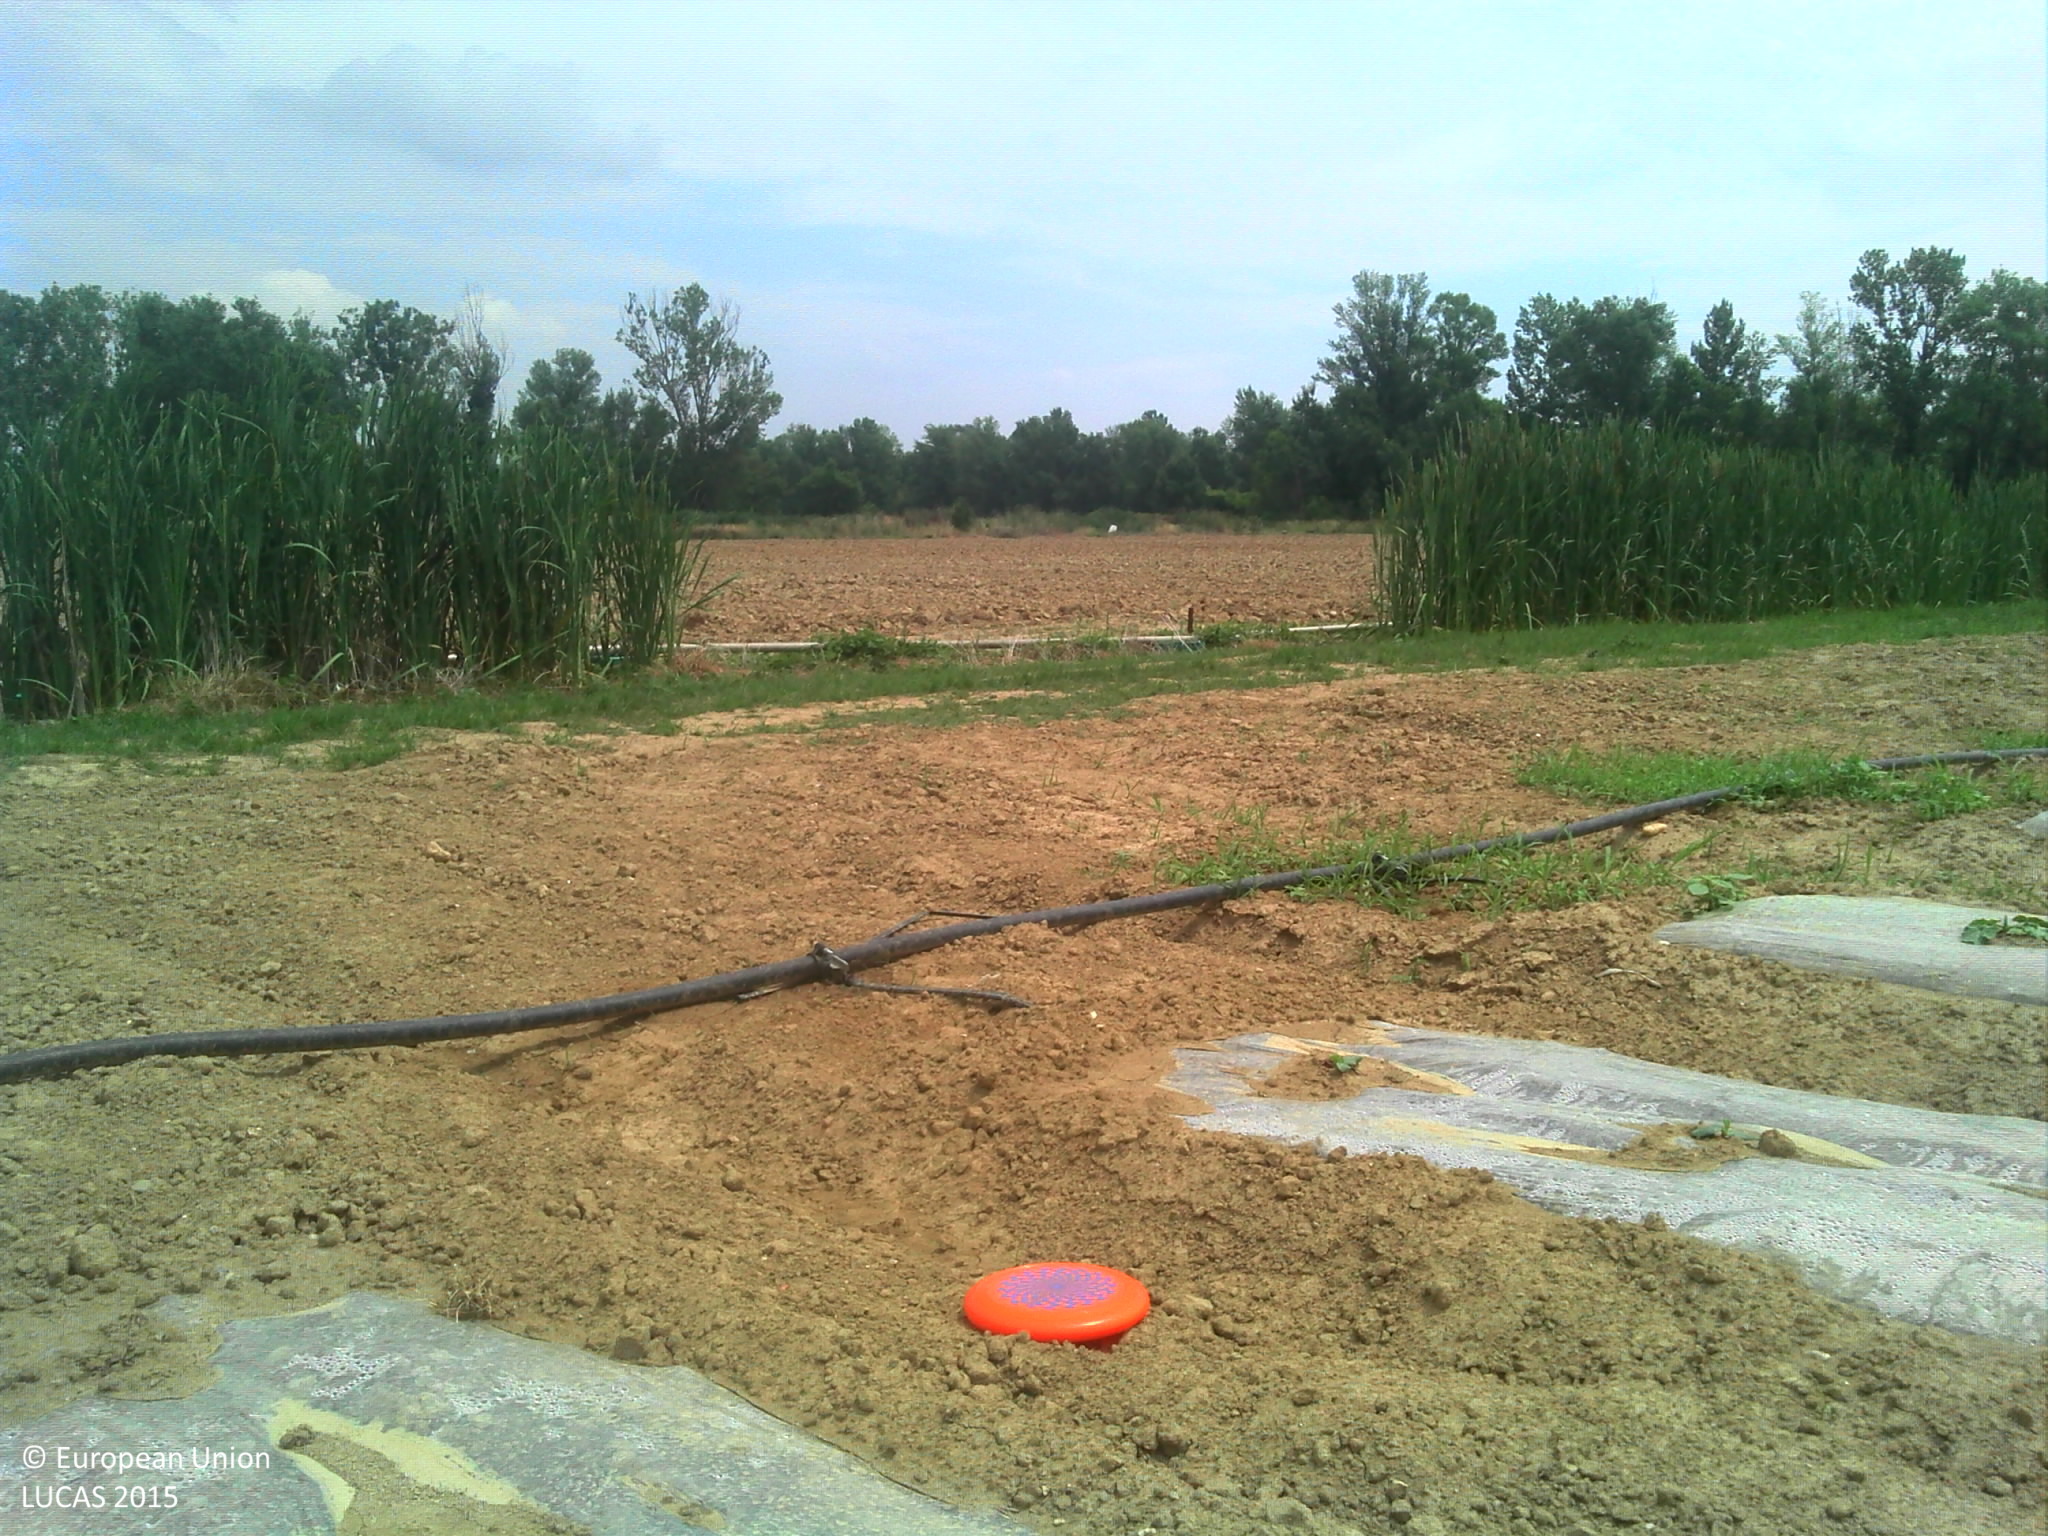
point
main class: Cropland
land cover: Other fresh vegetables
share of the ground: < 10 %
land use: Agriculture (excluding fallow land and kitchen gardens)
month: June
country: FR
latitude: 43.5991
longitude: 2.1392
